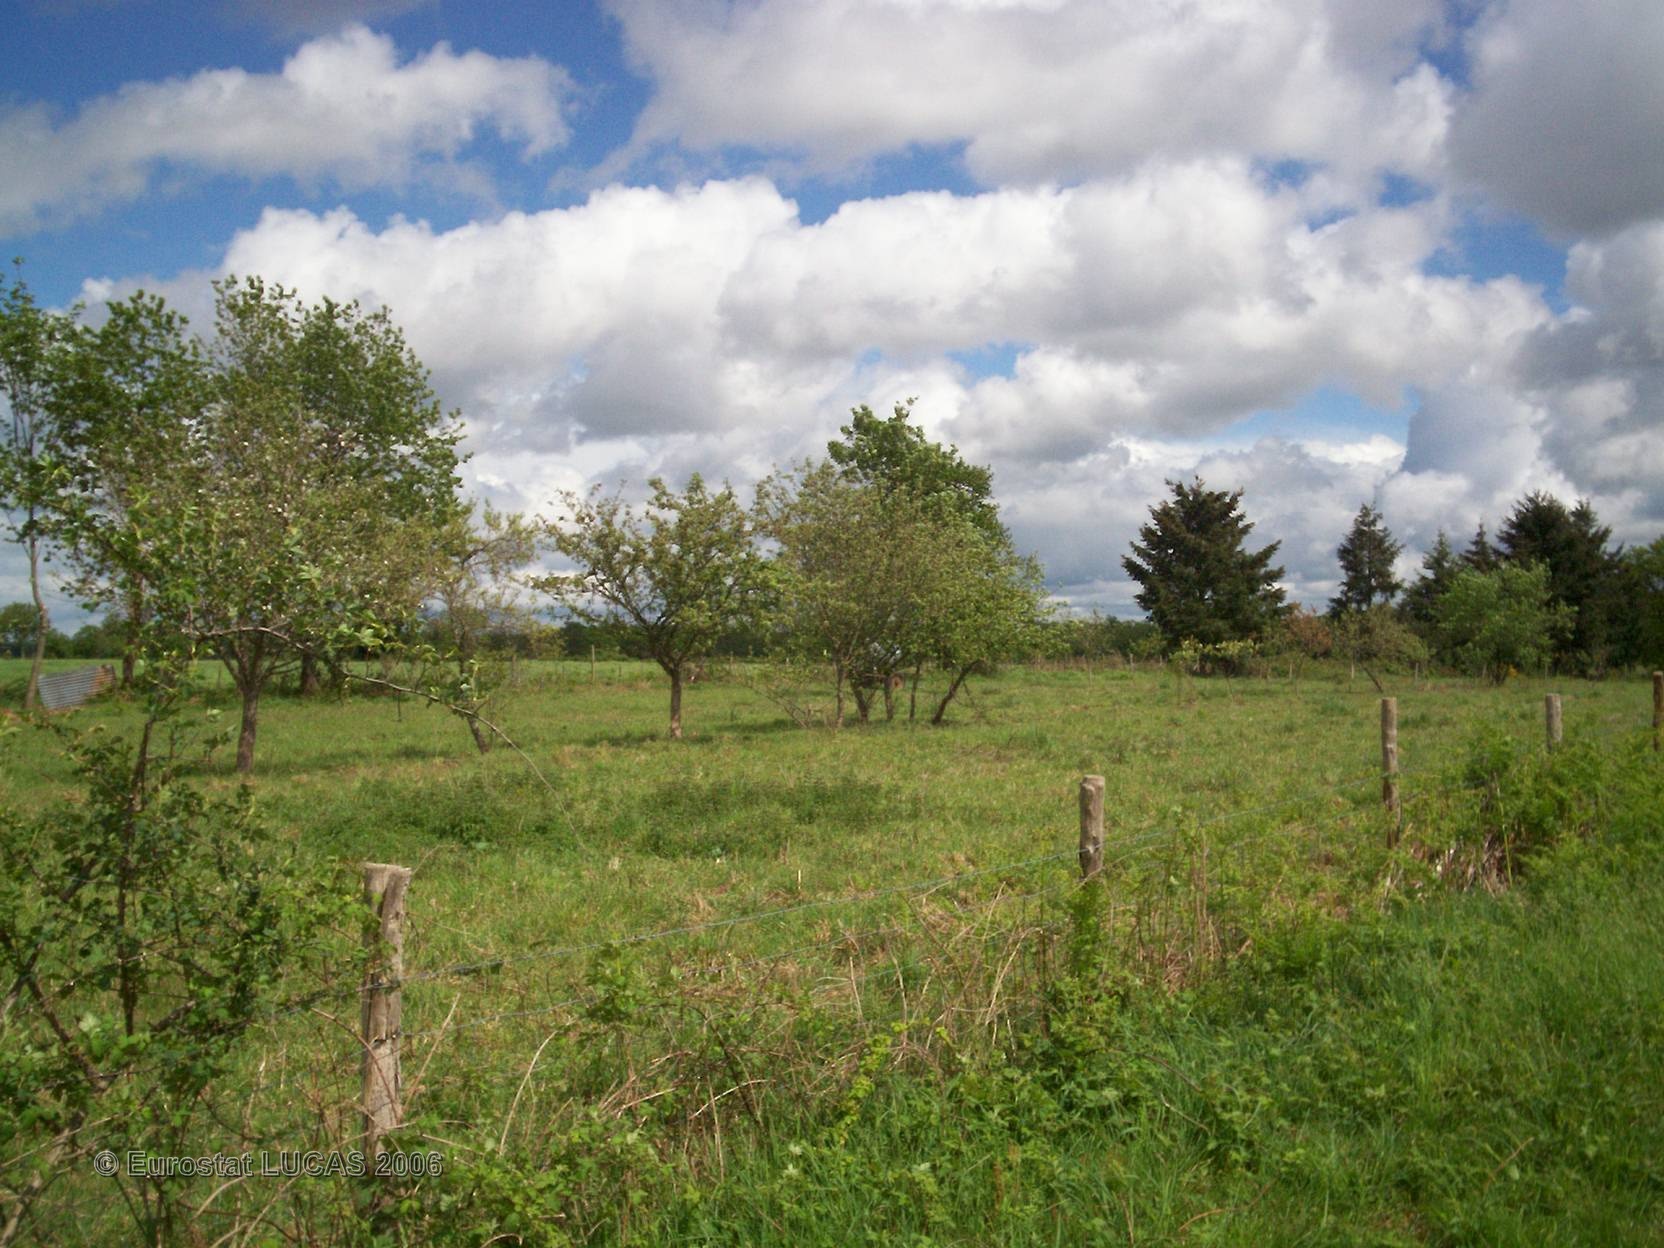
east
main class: Grassland
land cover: Grassland without tree/shrub cover
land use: Agriculture (excluding fallow land and kitchen gardens)
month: May
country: FR
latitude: 45.9817
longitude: 0.4973
